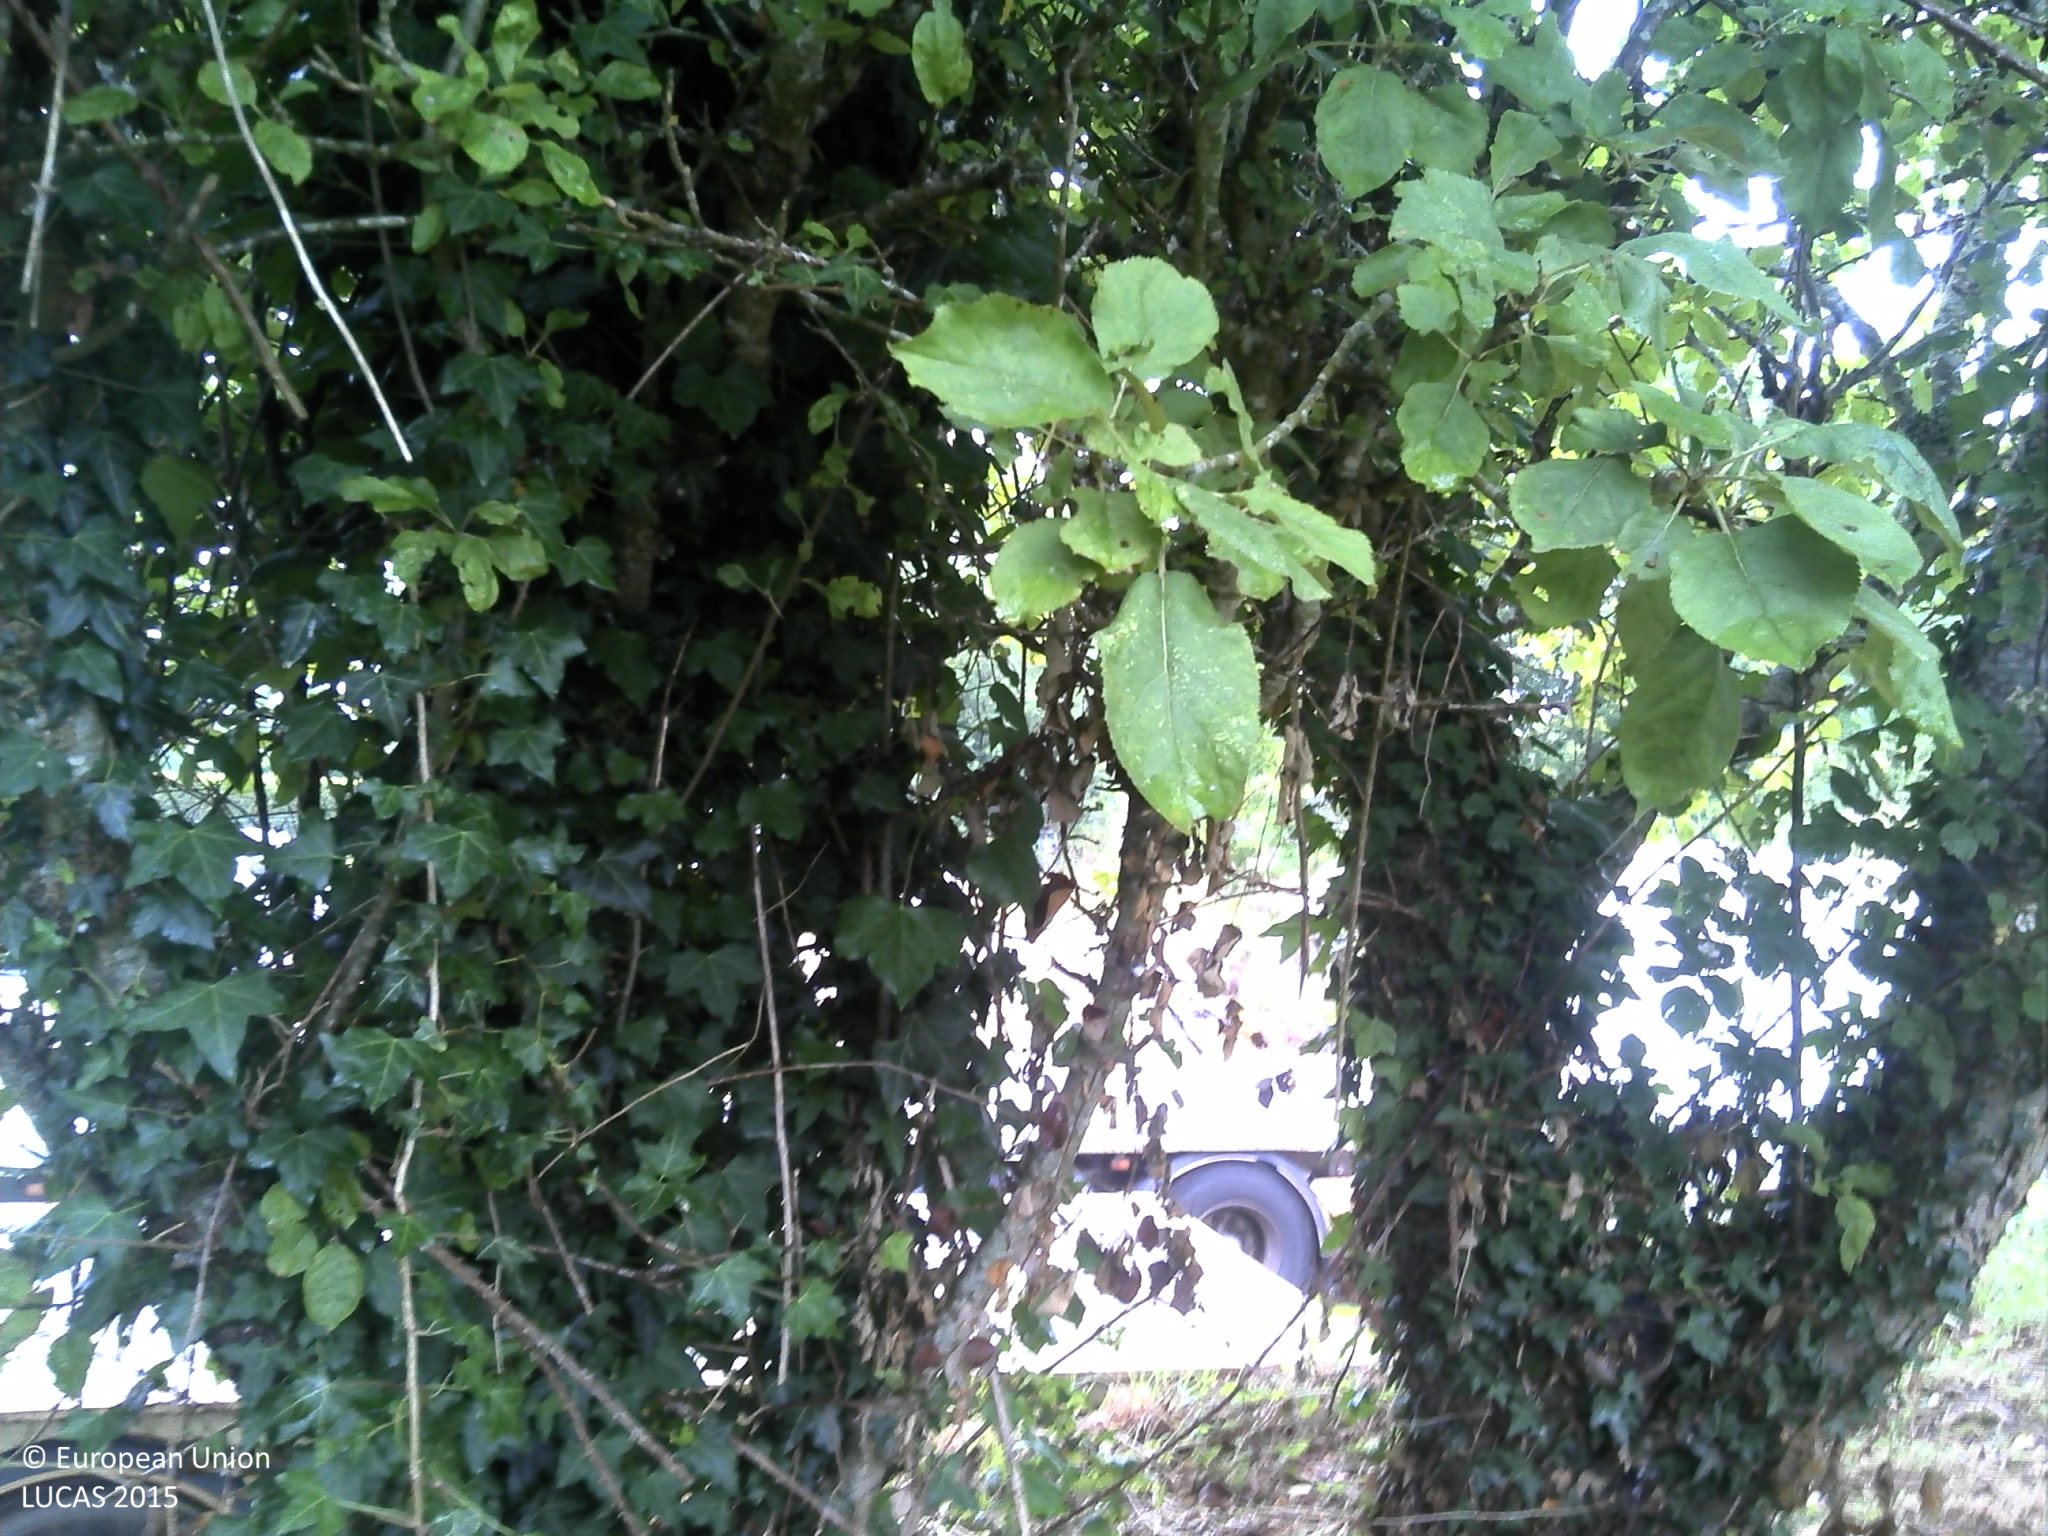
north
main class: Grassland
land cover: Grassland with sparse tree/shrub cover
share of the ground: > 75 %
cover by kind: herbaceous plants 85 %, shrubs 10 %, coniferous forest trees 5 %
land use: Residential
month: July
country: FR
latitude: 48.2176
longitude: -4.1553
